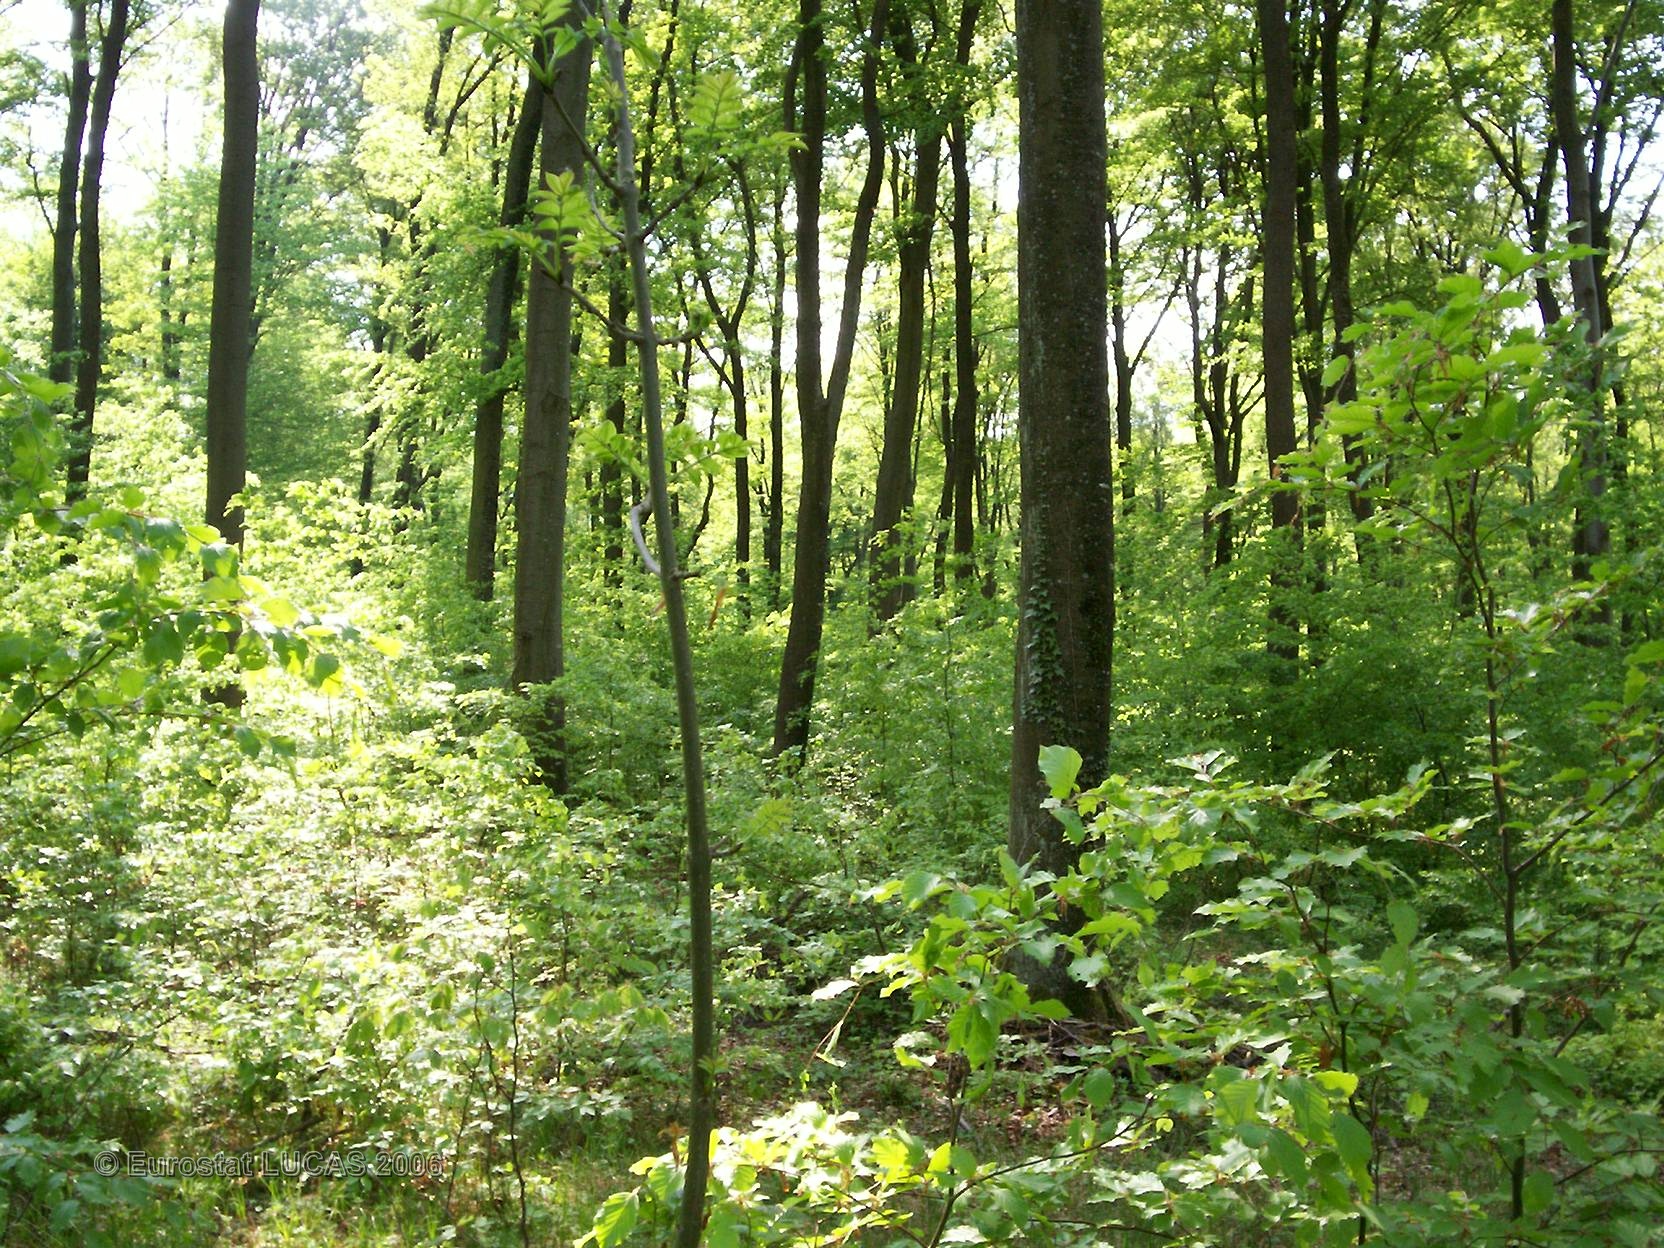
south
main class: Woodland
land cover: Broadleaved forest
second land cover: Grassland with sparse tree/shrub cover
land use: Forestry
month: May
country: FR
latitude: 47.7002
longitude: 7.1365
